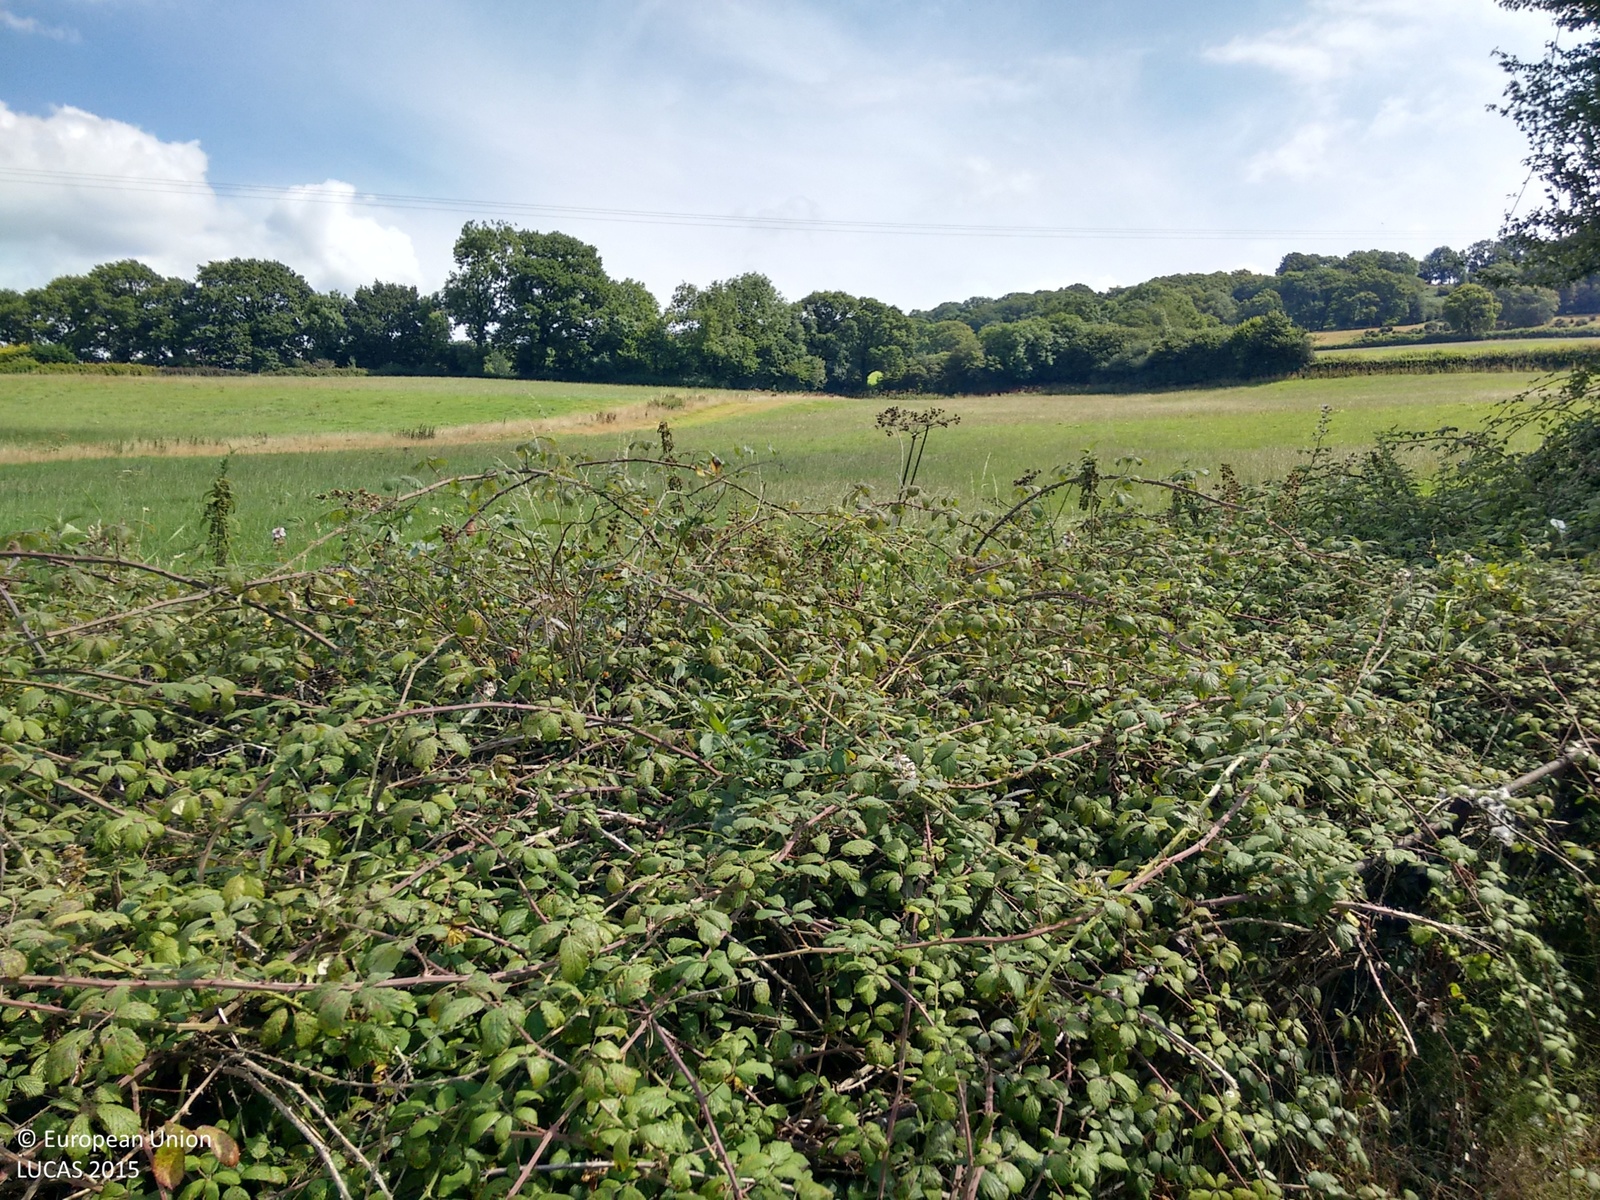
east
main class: Grassland
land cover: Grassland without tree/shrub cover
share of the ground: > 75 %
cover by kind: herbaceous plants 100 %
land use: Agriculture (excluding fallow land and kitchen gardens)
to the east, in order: Grassland without tree/shrub cover; Shruby margins; Managed hedges; Grassland without tree/shrub cover; Broadleaved woodland; Grassland without tree/shrub cover
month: August
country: GB
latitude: 50.8216
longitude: -3.1512
